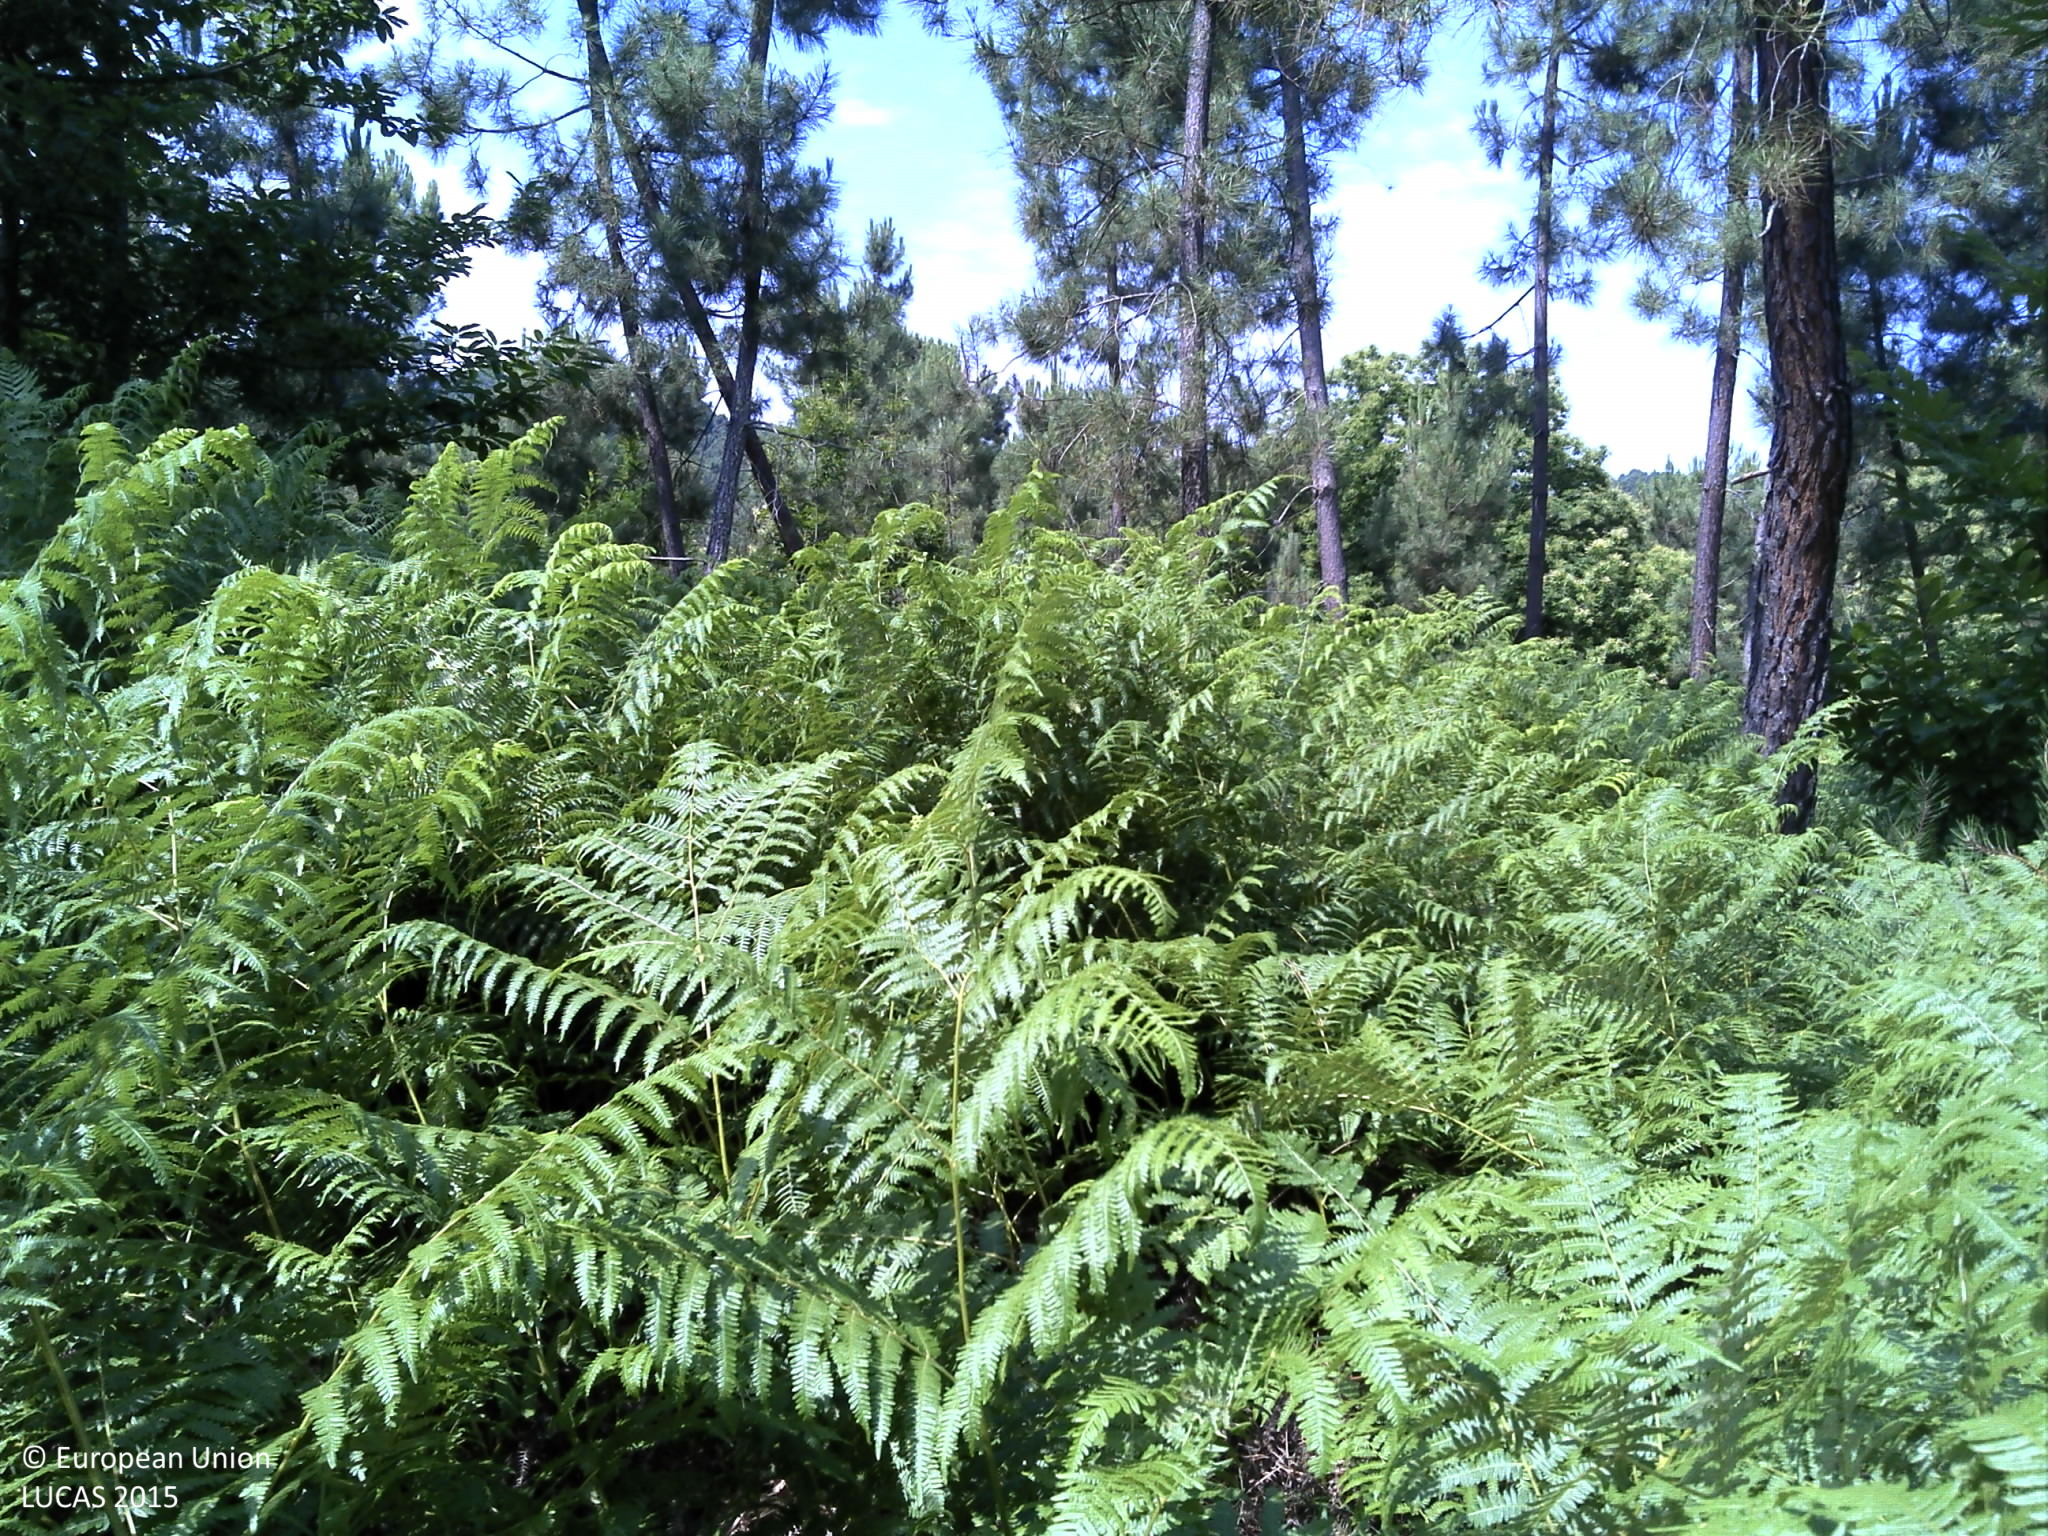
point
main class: Woodland
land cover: Pine dominated coniferous woodland
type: coniferous forest of the mediterranean region
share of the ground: 25 - 50 %
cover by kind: shrubs 70 %, coniferous forest trees 30 %
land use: Forestry
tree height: > 5 m
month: June
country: PT
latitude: 41.2489
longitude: -7.5842
